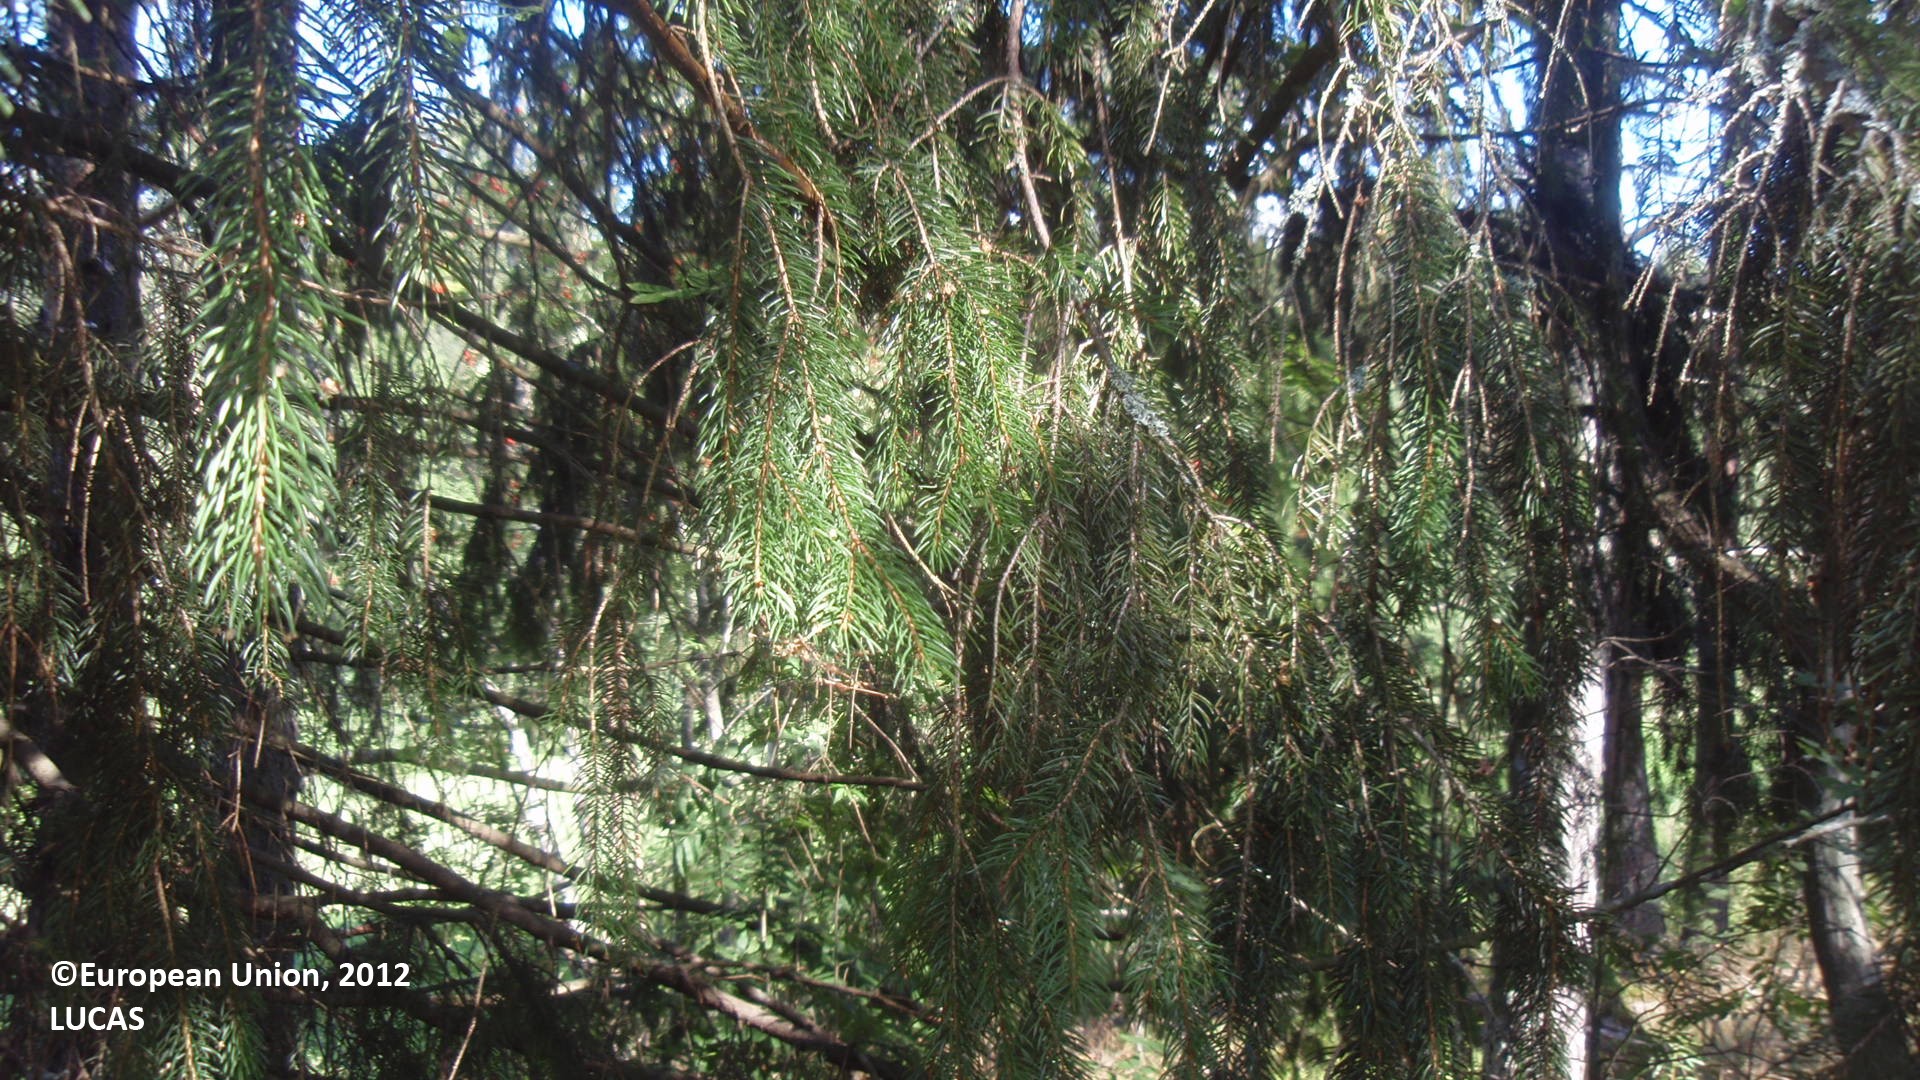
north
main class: Woodland
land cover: Pine dominated mixed woodland
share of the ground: 50 - 75 %
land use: Forestry
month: August
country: FI
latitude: 61.4621
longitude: 27.8074
